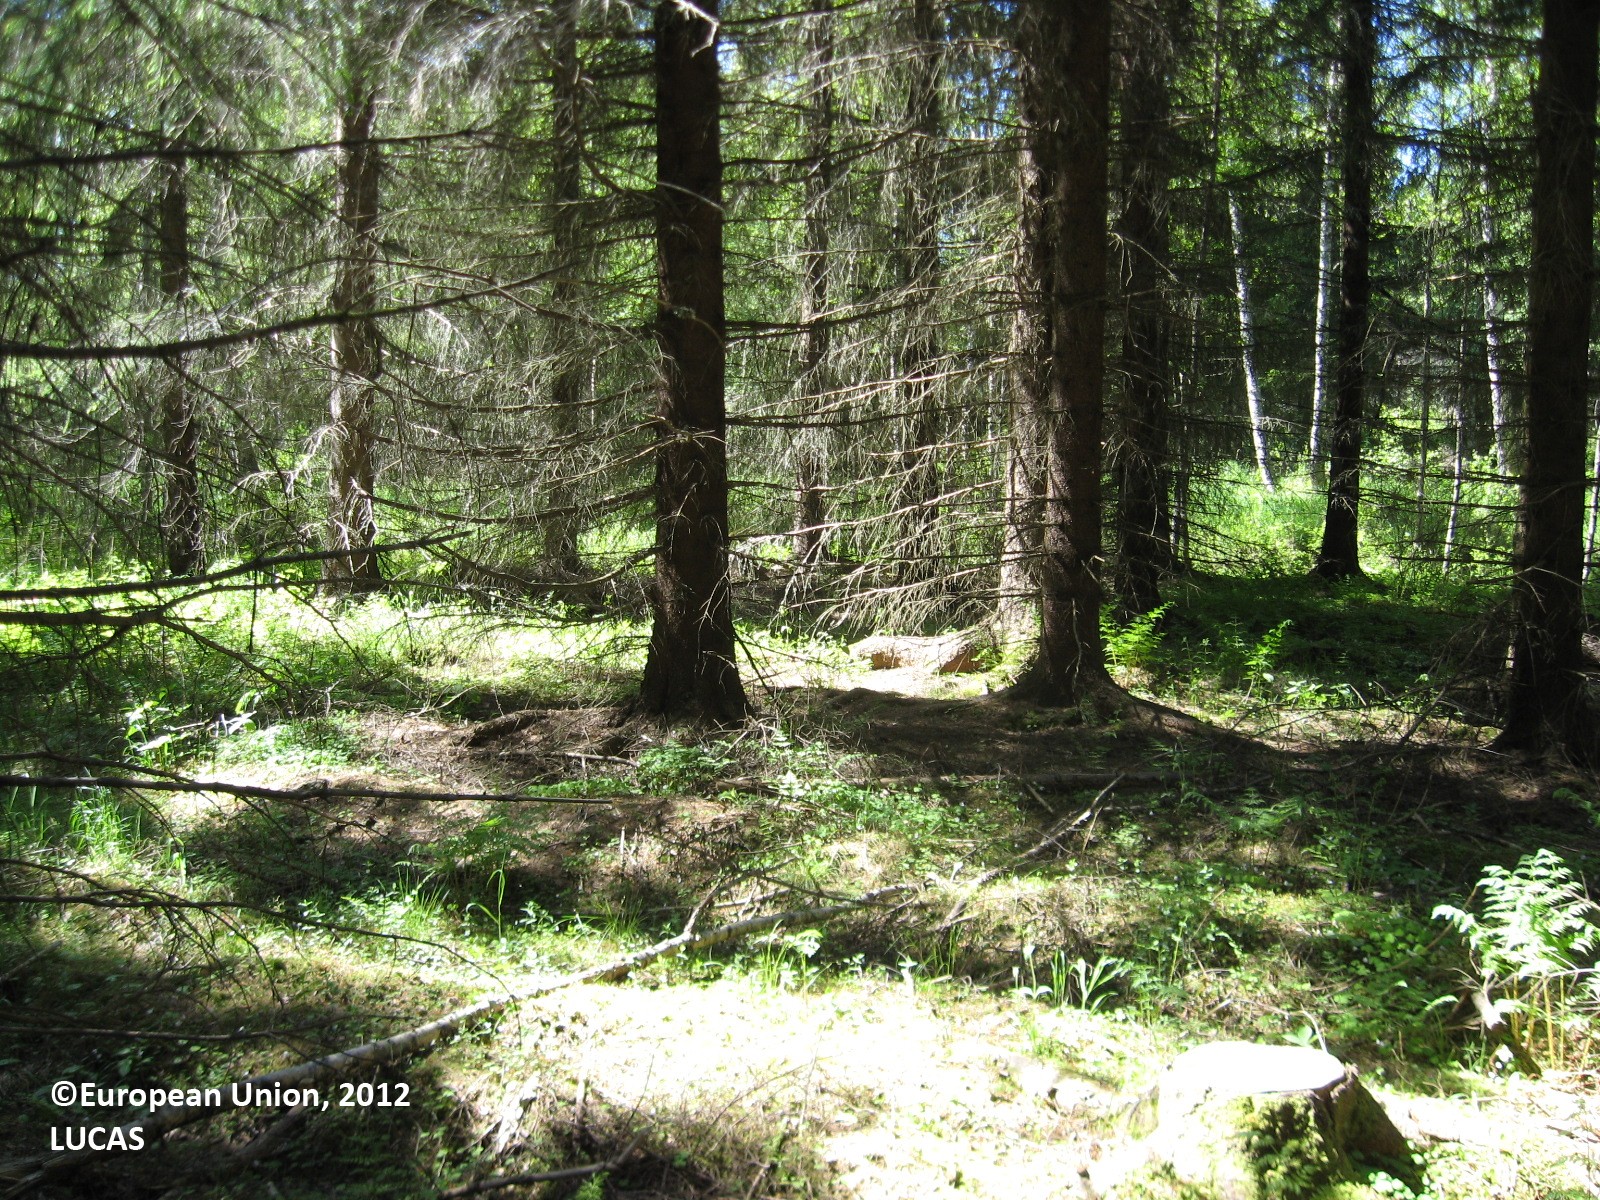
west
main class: Woodland
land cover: Spruce dominated coniferous woodland
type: boreal forest
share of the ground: > 75 %
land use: Forestry
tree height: > 5 m
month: June
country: FI
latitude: 63.2279
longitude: 21.7610
